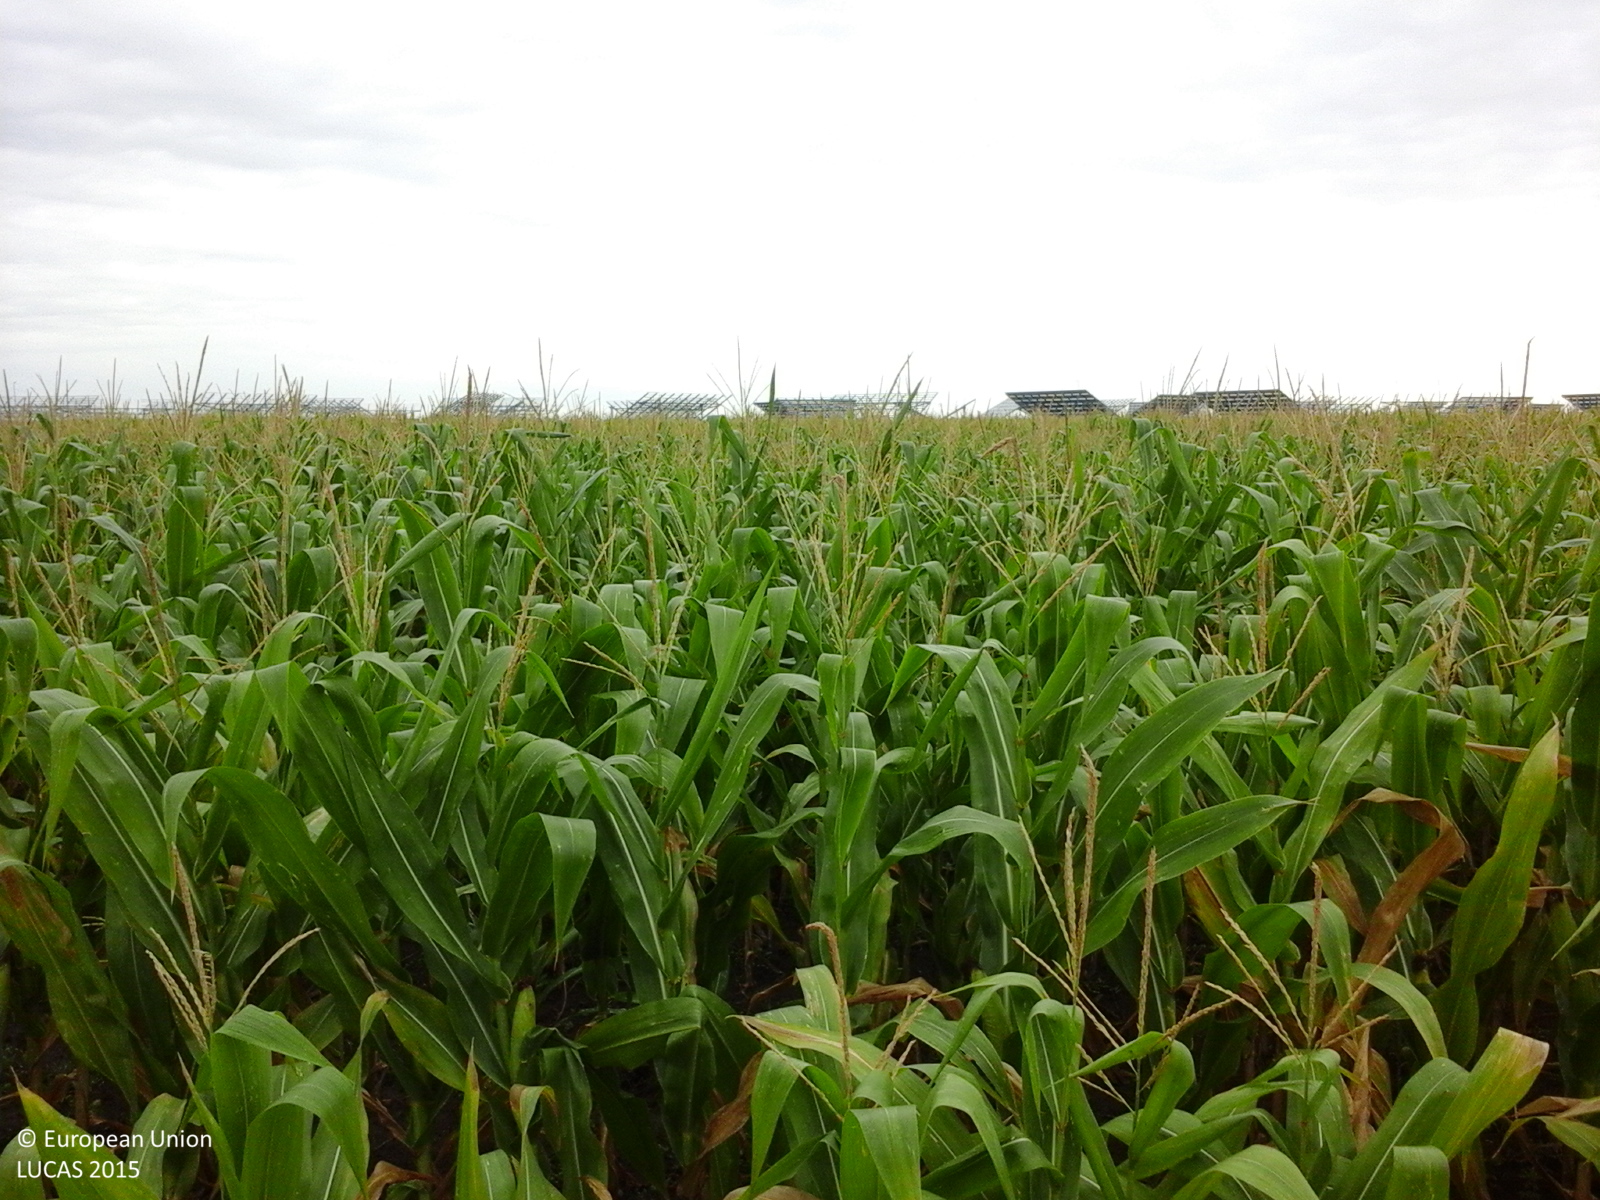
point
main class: Cropland
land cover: Maize
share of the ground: > 75 %
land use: Agriculture (excluding fallow land and kitchen gardens)
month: August
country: RO
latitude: 45.4516
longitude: 21.3723
